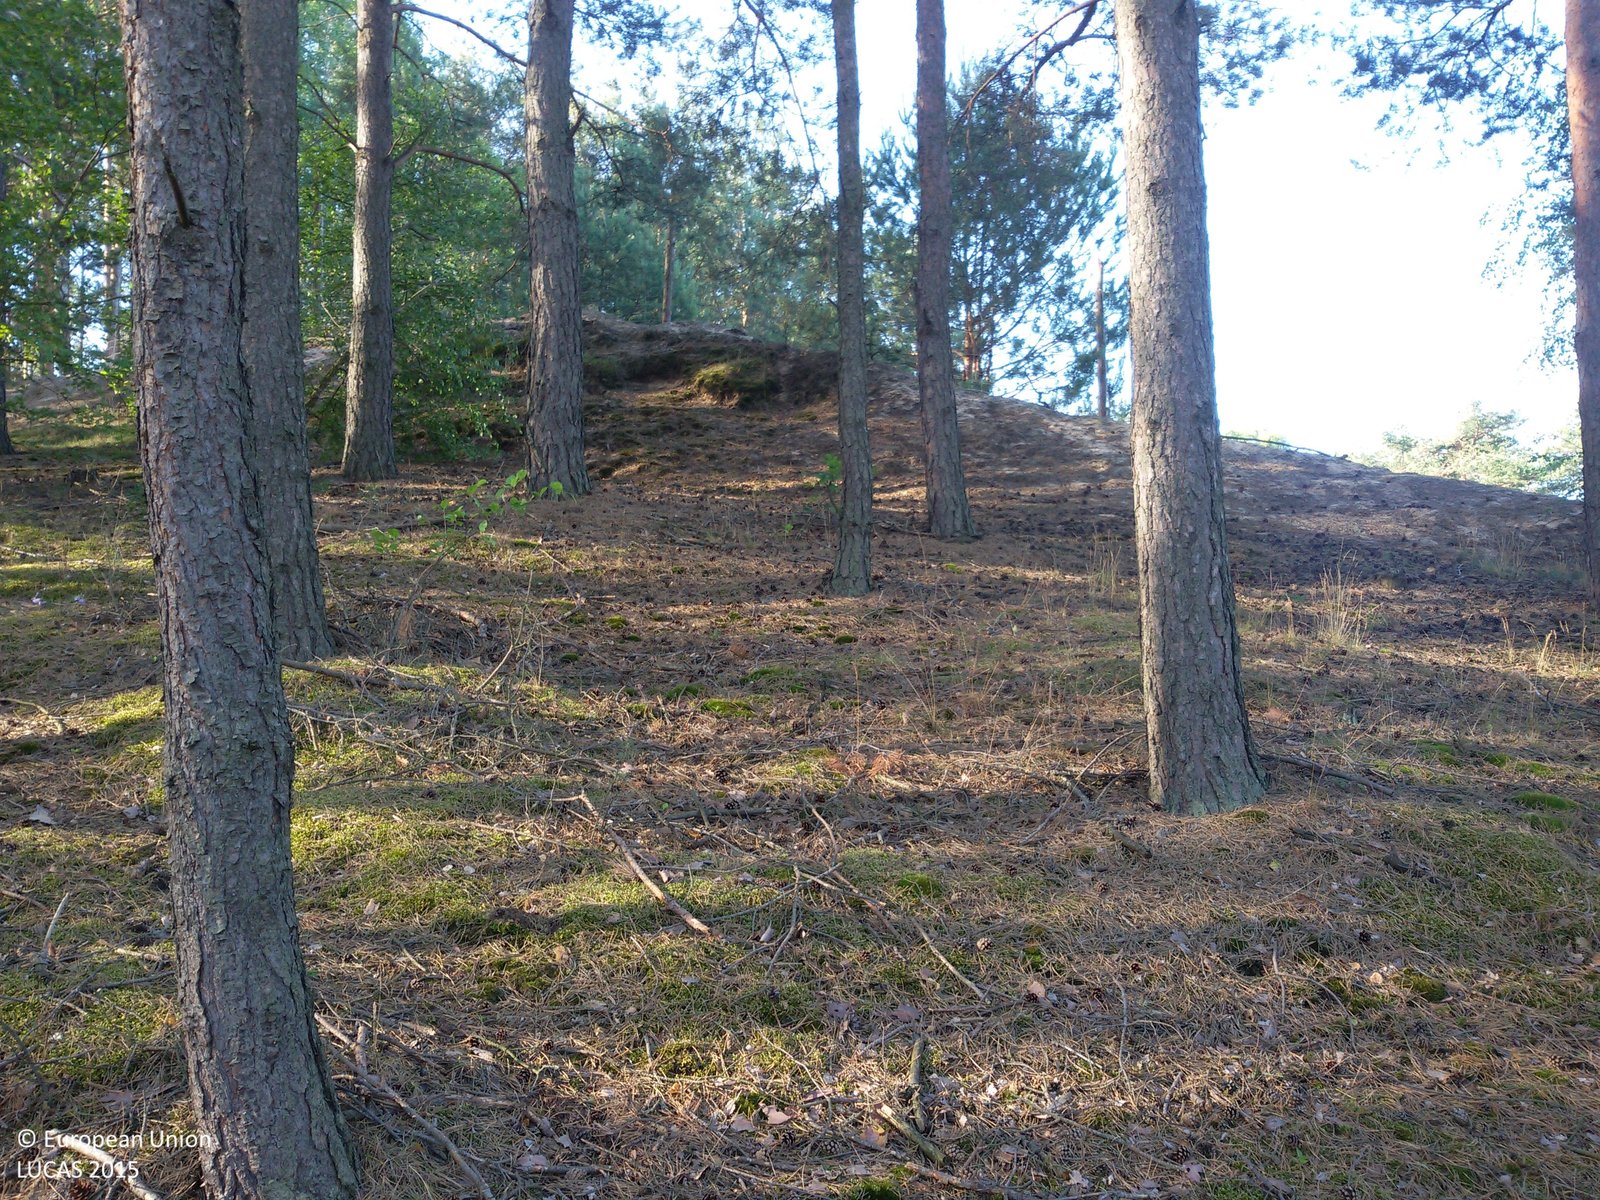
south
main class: Woodland
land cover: Pine dominated coniferous woodland
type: hemiboreal forest and nemoral coniferous forest and mixed broadleaved-coniferous forest
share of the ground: > 75 %
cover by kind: coniferous forest trees 80 %, herbaceous plants 10 %, shrubs 5 %, lichens and mosses 5 %
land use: Forestry
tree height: > 5 m
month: July
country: PL
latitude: 52.6105
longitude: 19.0465
